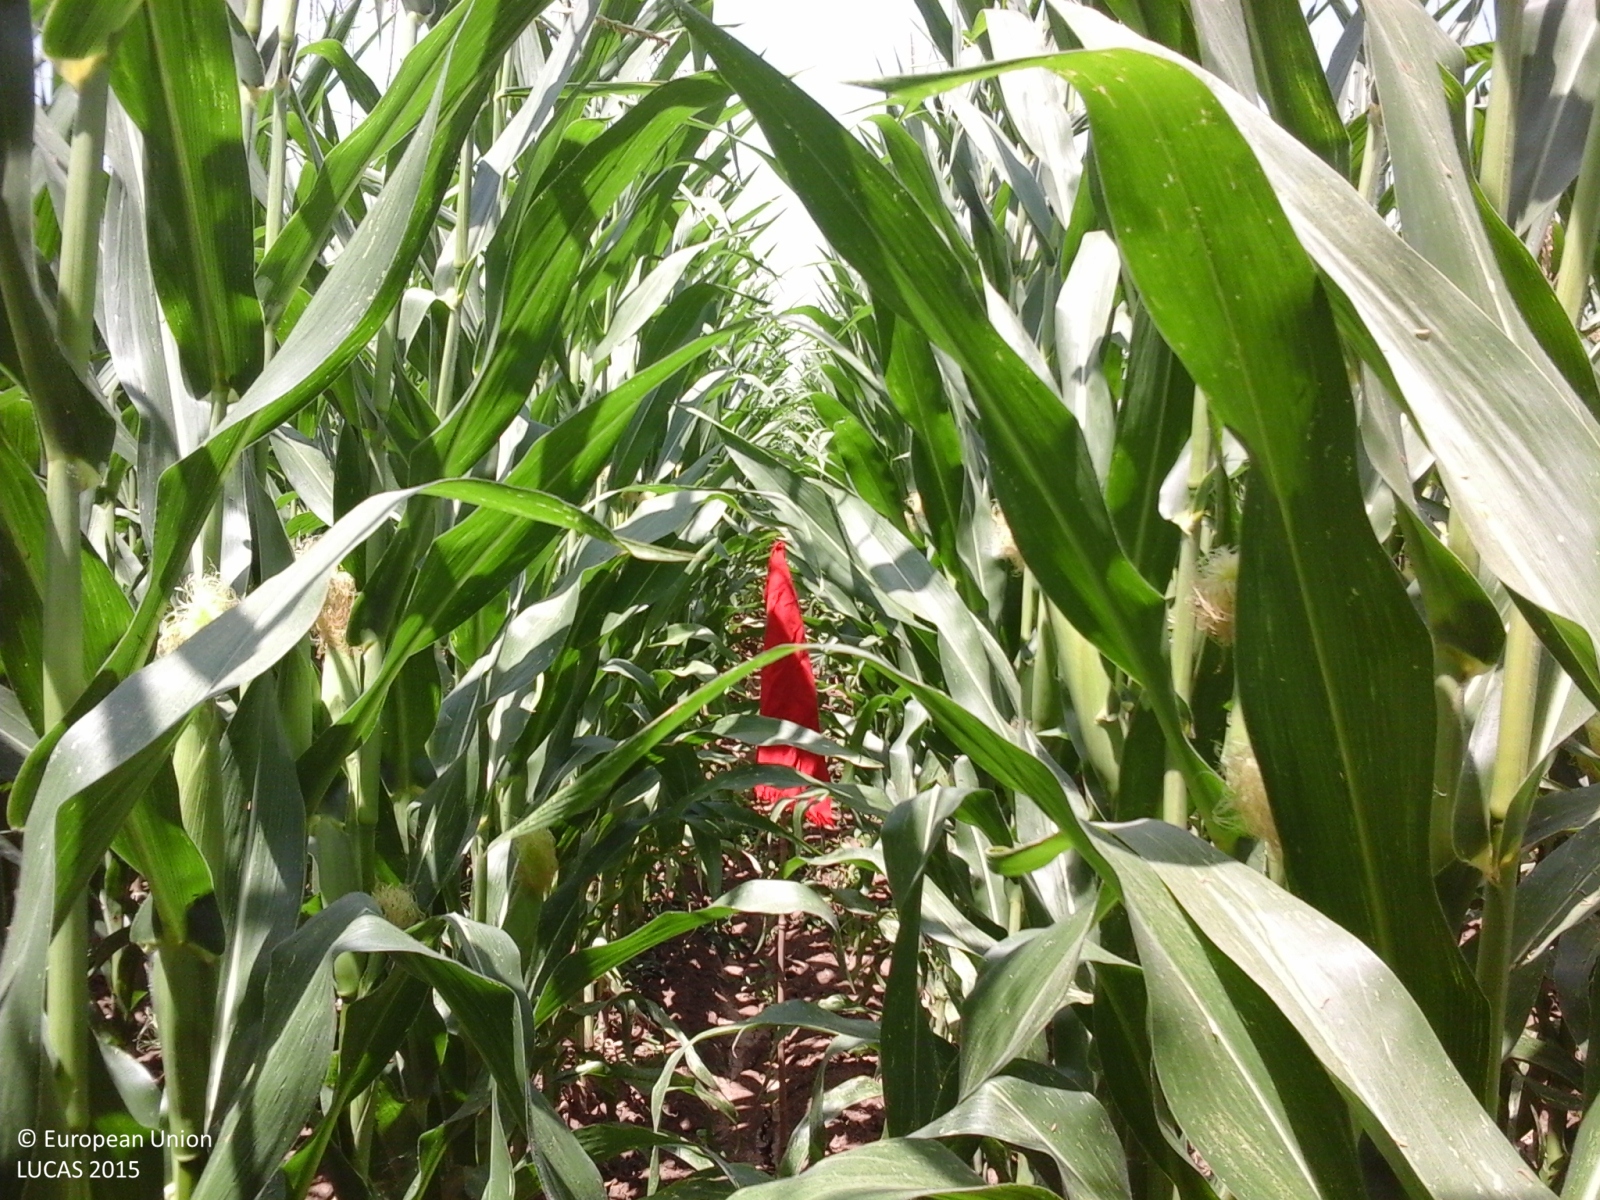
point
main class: Cropland
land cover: Maize
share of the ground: > 75 %
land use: Agriculture (excluding fallow land and kitchen gardens)
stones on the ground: < 10 %
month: July
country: IT
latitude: 43.3703
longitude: 13.5084
